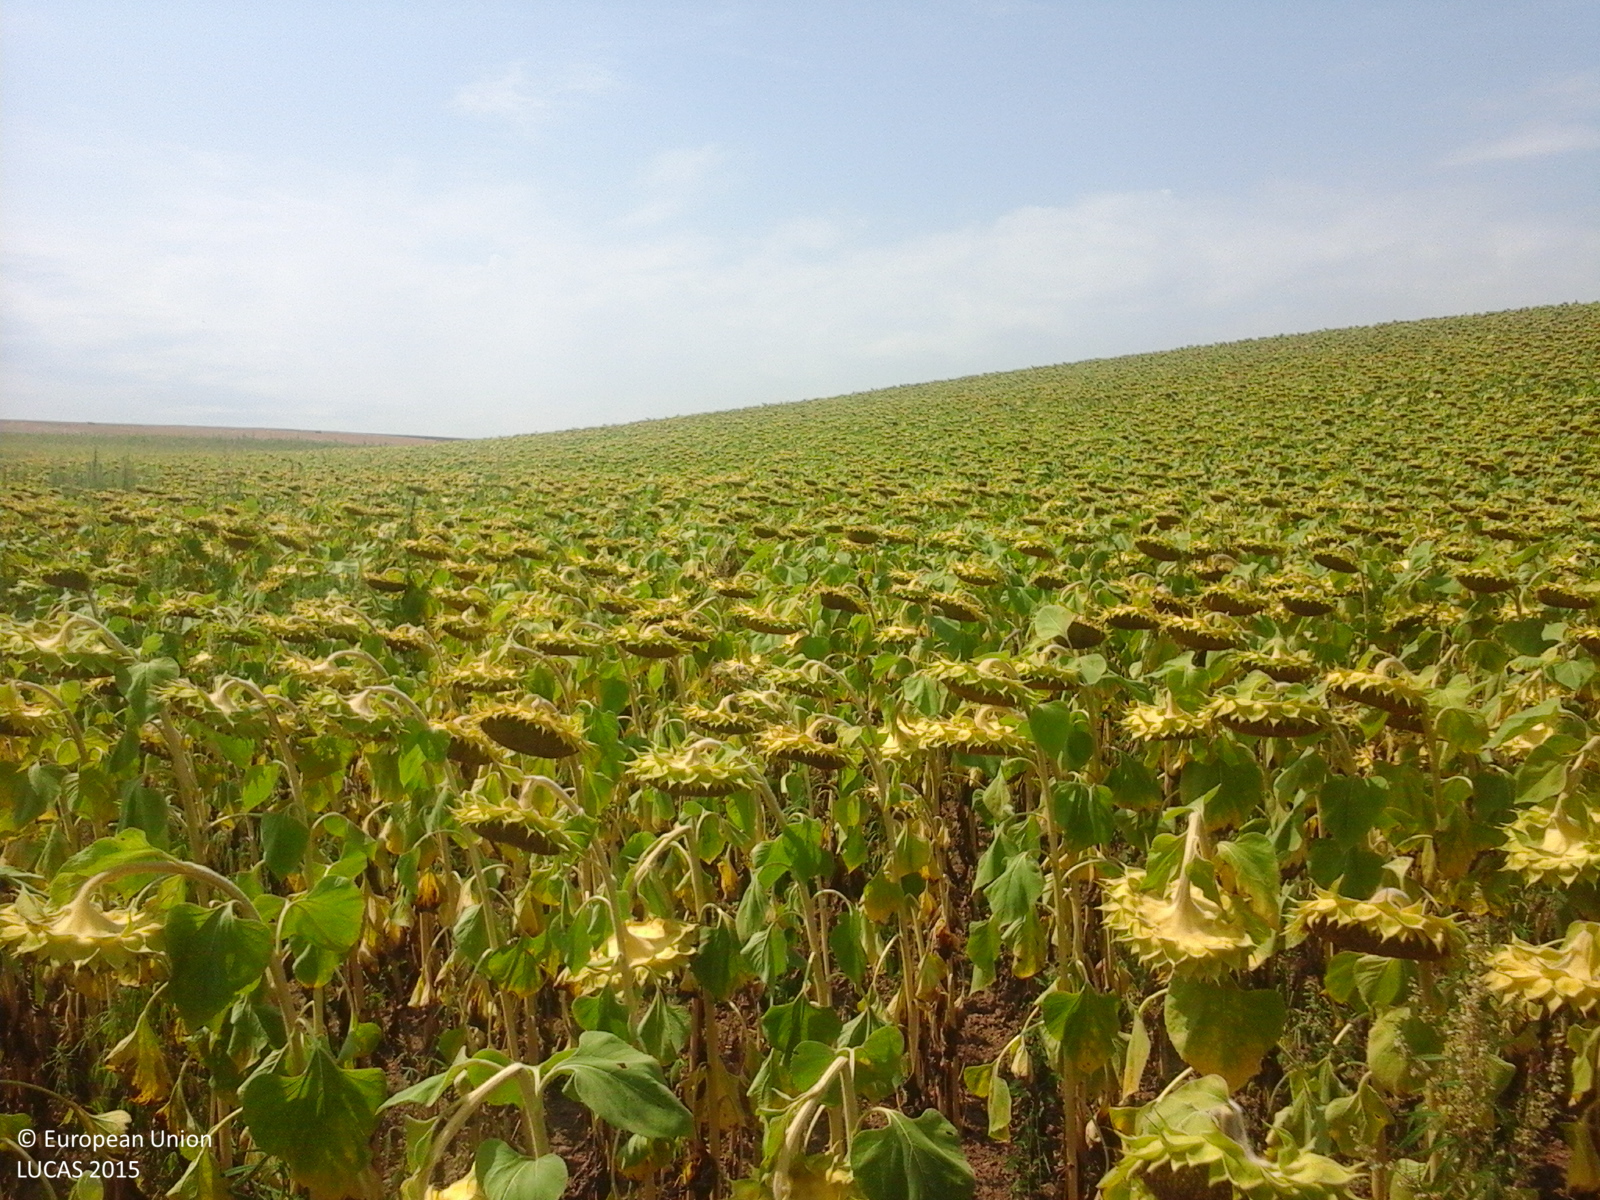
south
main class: Cropland
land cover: Sunflower
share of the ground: > 75 %
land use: Agriculture (excluding fallow land and kitchen gardens)
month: August
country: RO
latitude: 44.0005
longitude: 27.7664
